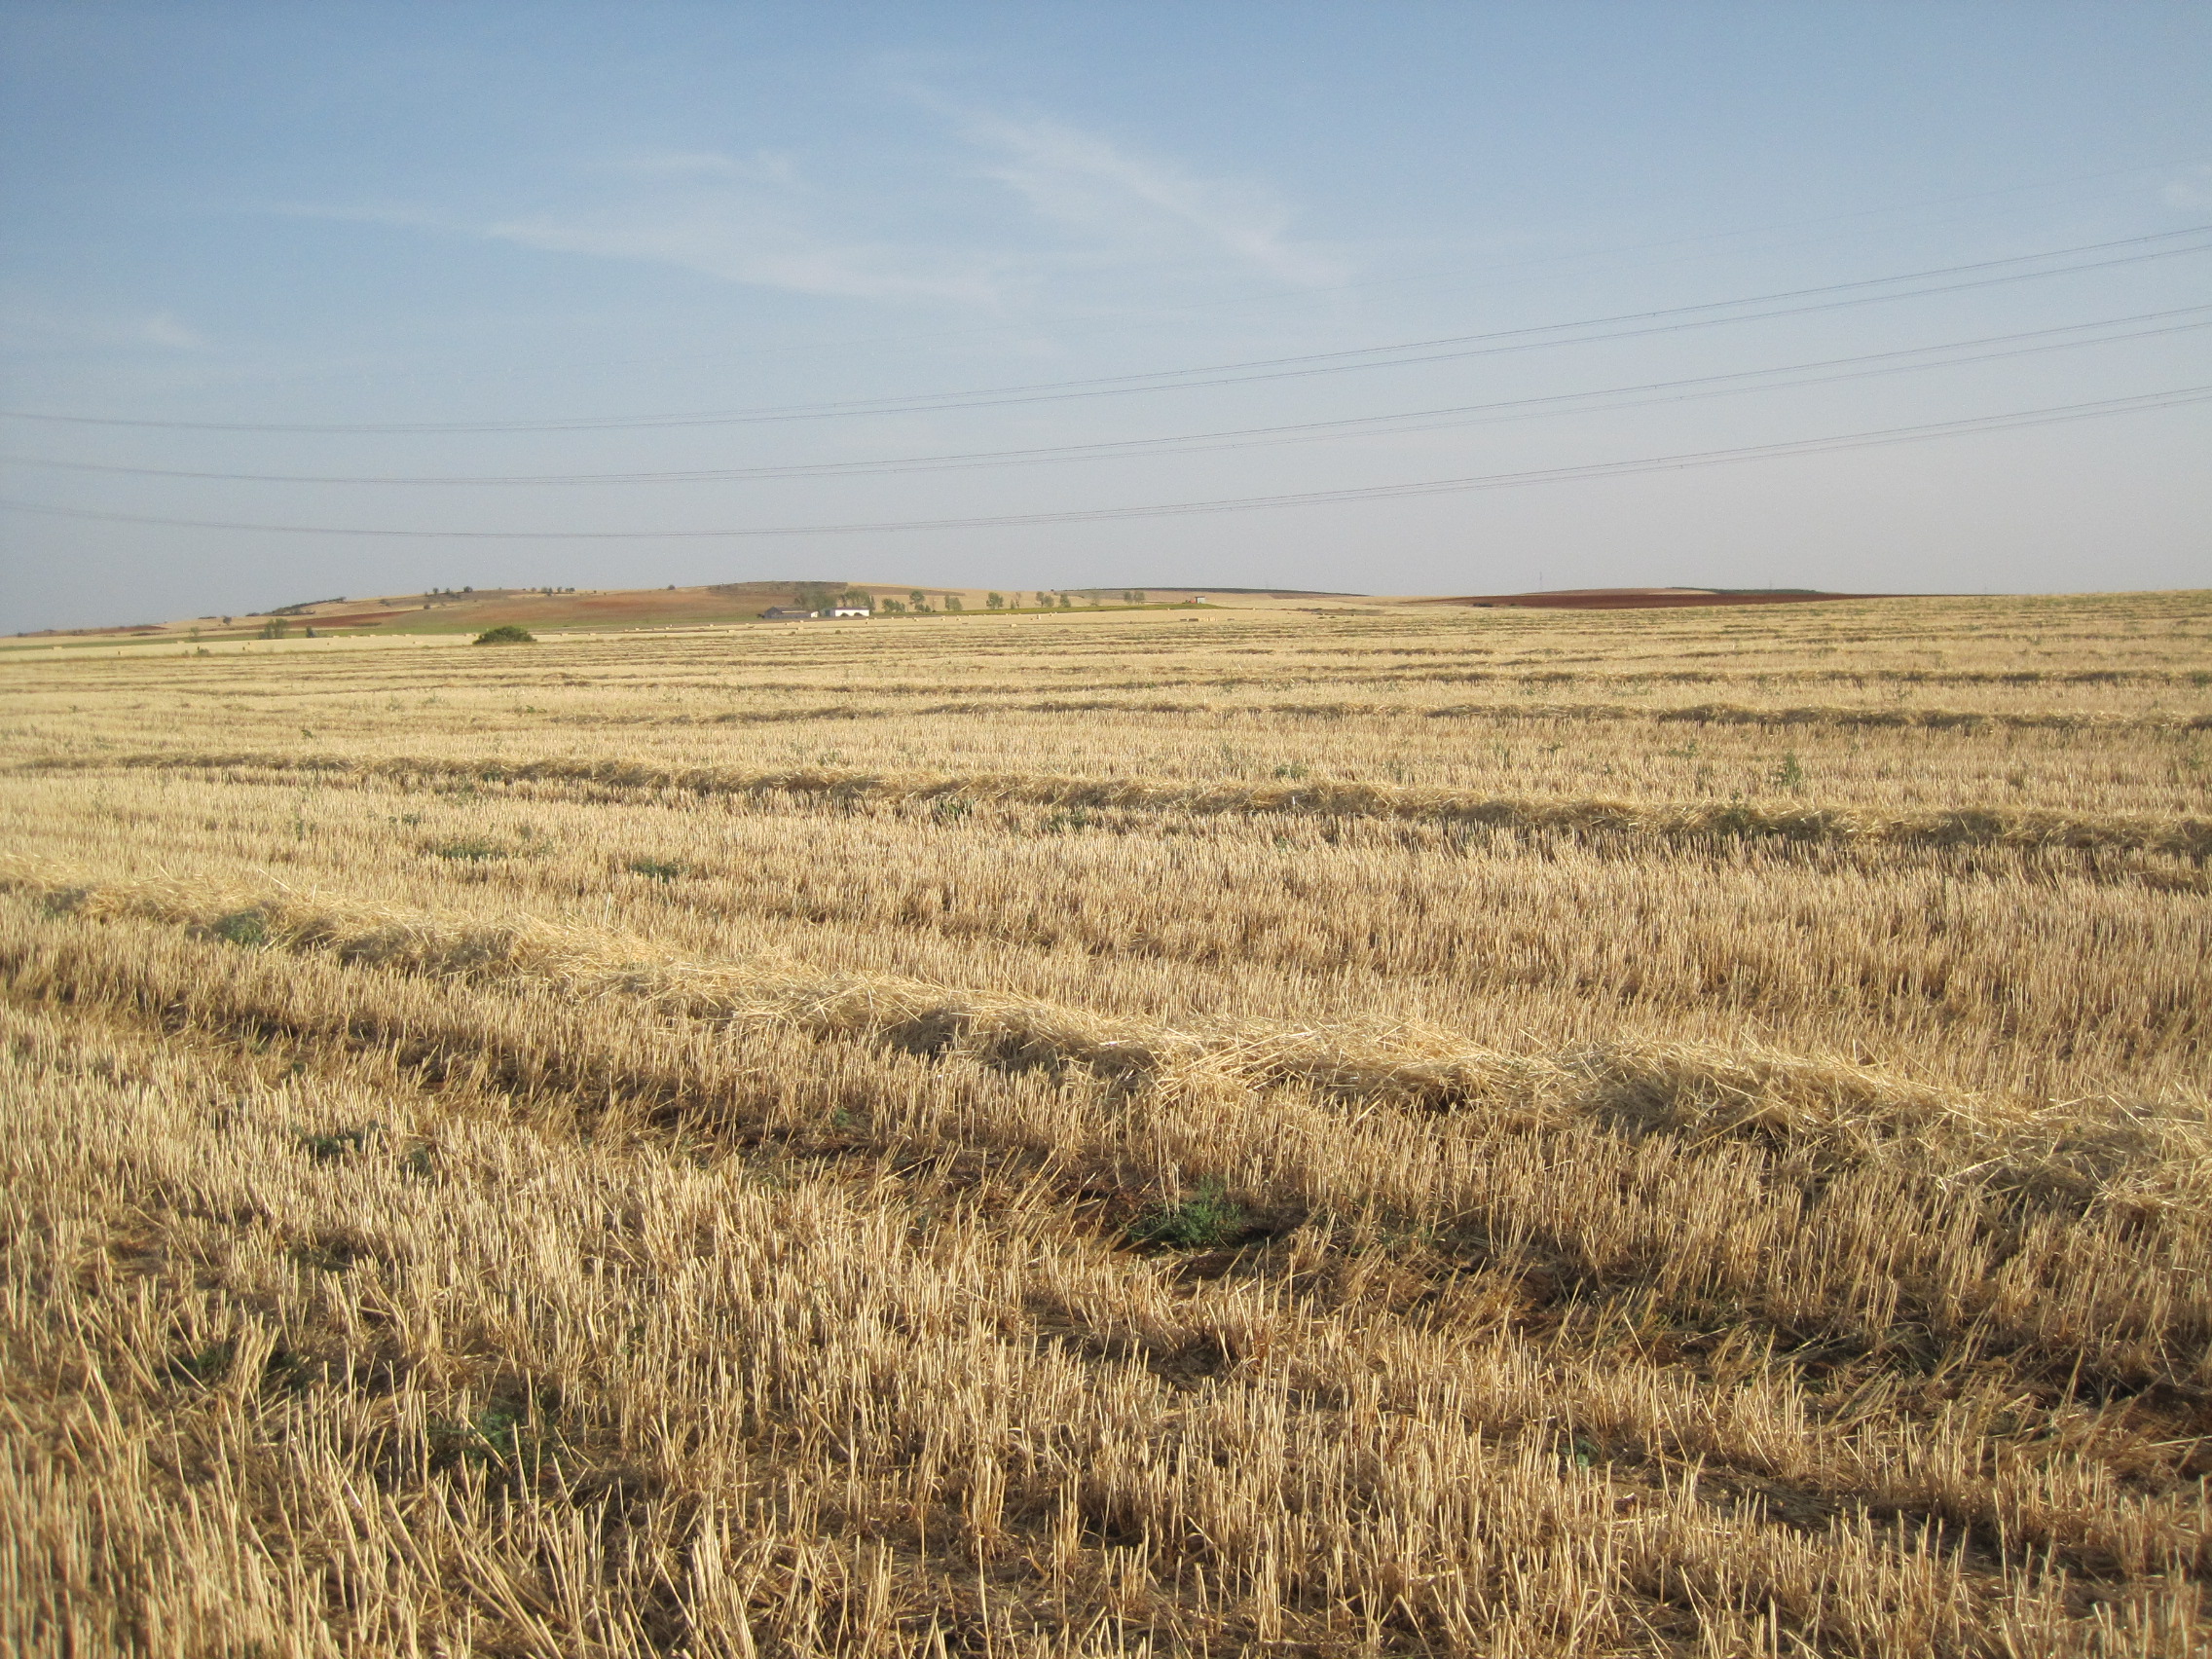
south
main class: Cropland
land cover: Barley
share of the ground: < 10 %
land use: Agriculture (excluding fallow land and kitchen gardens)
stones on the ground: 25 - 50 %
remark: Harvested field
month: July
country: ES
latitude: 41.6662
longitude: -5.5417
